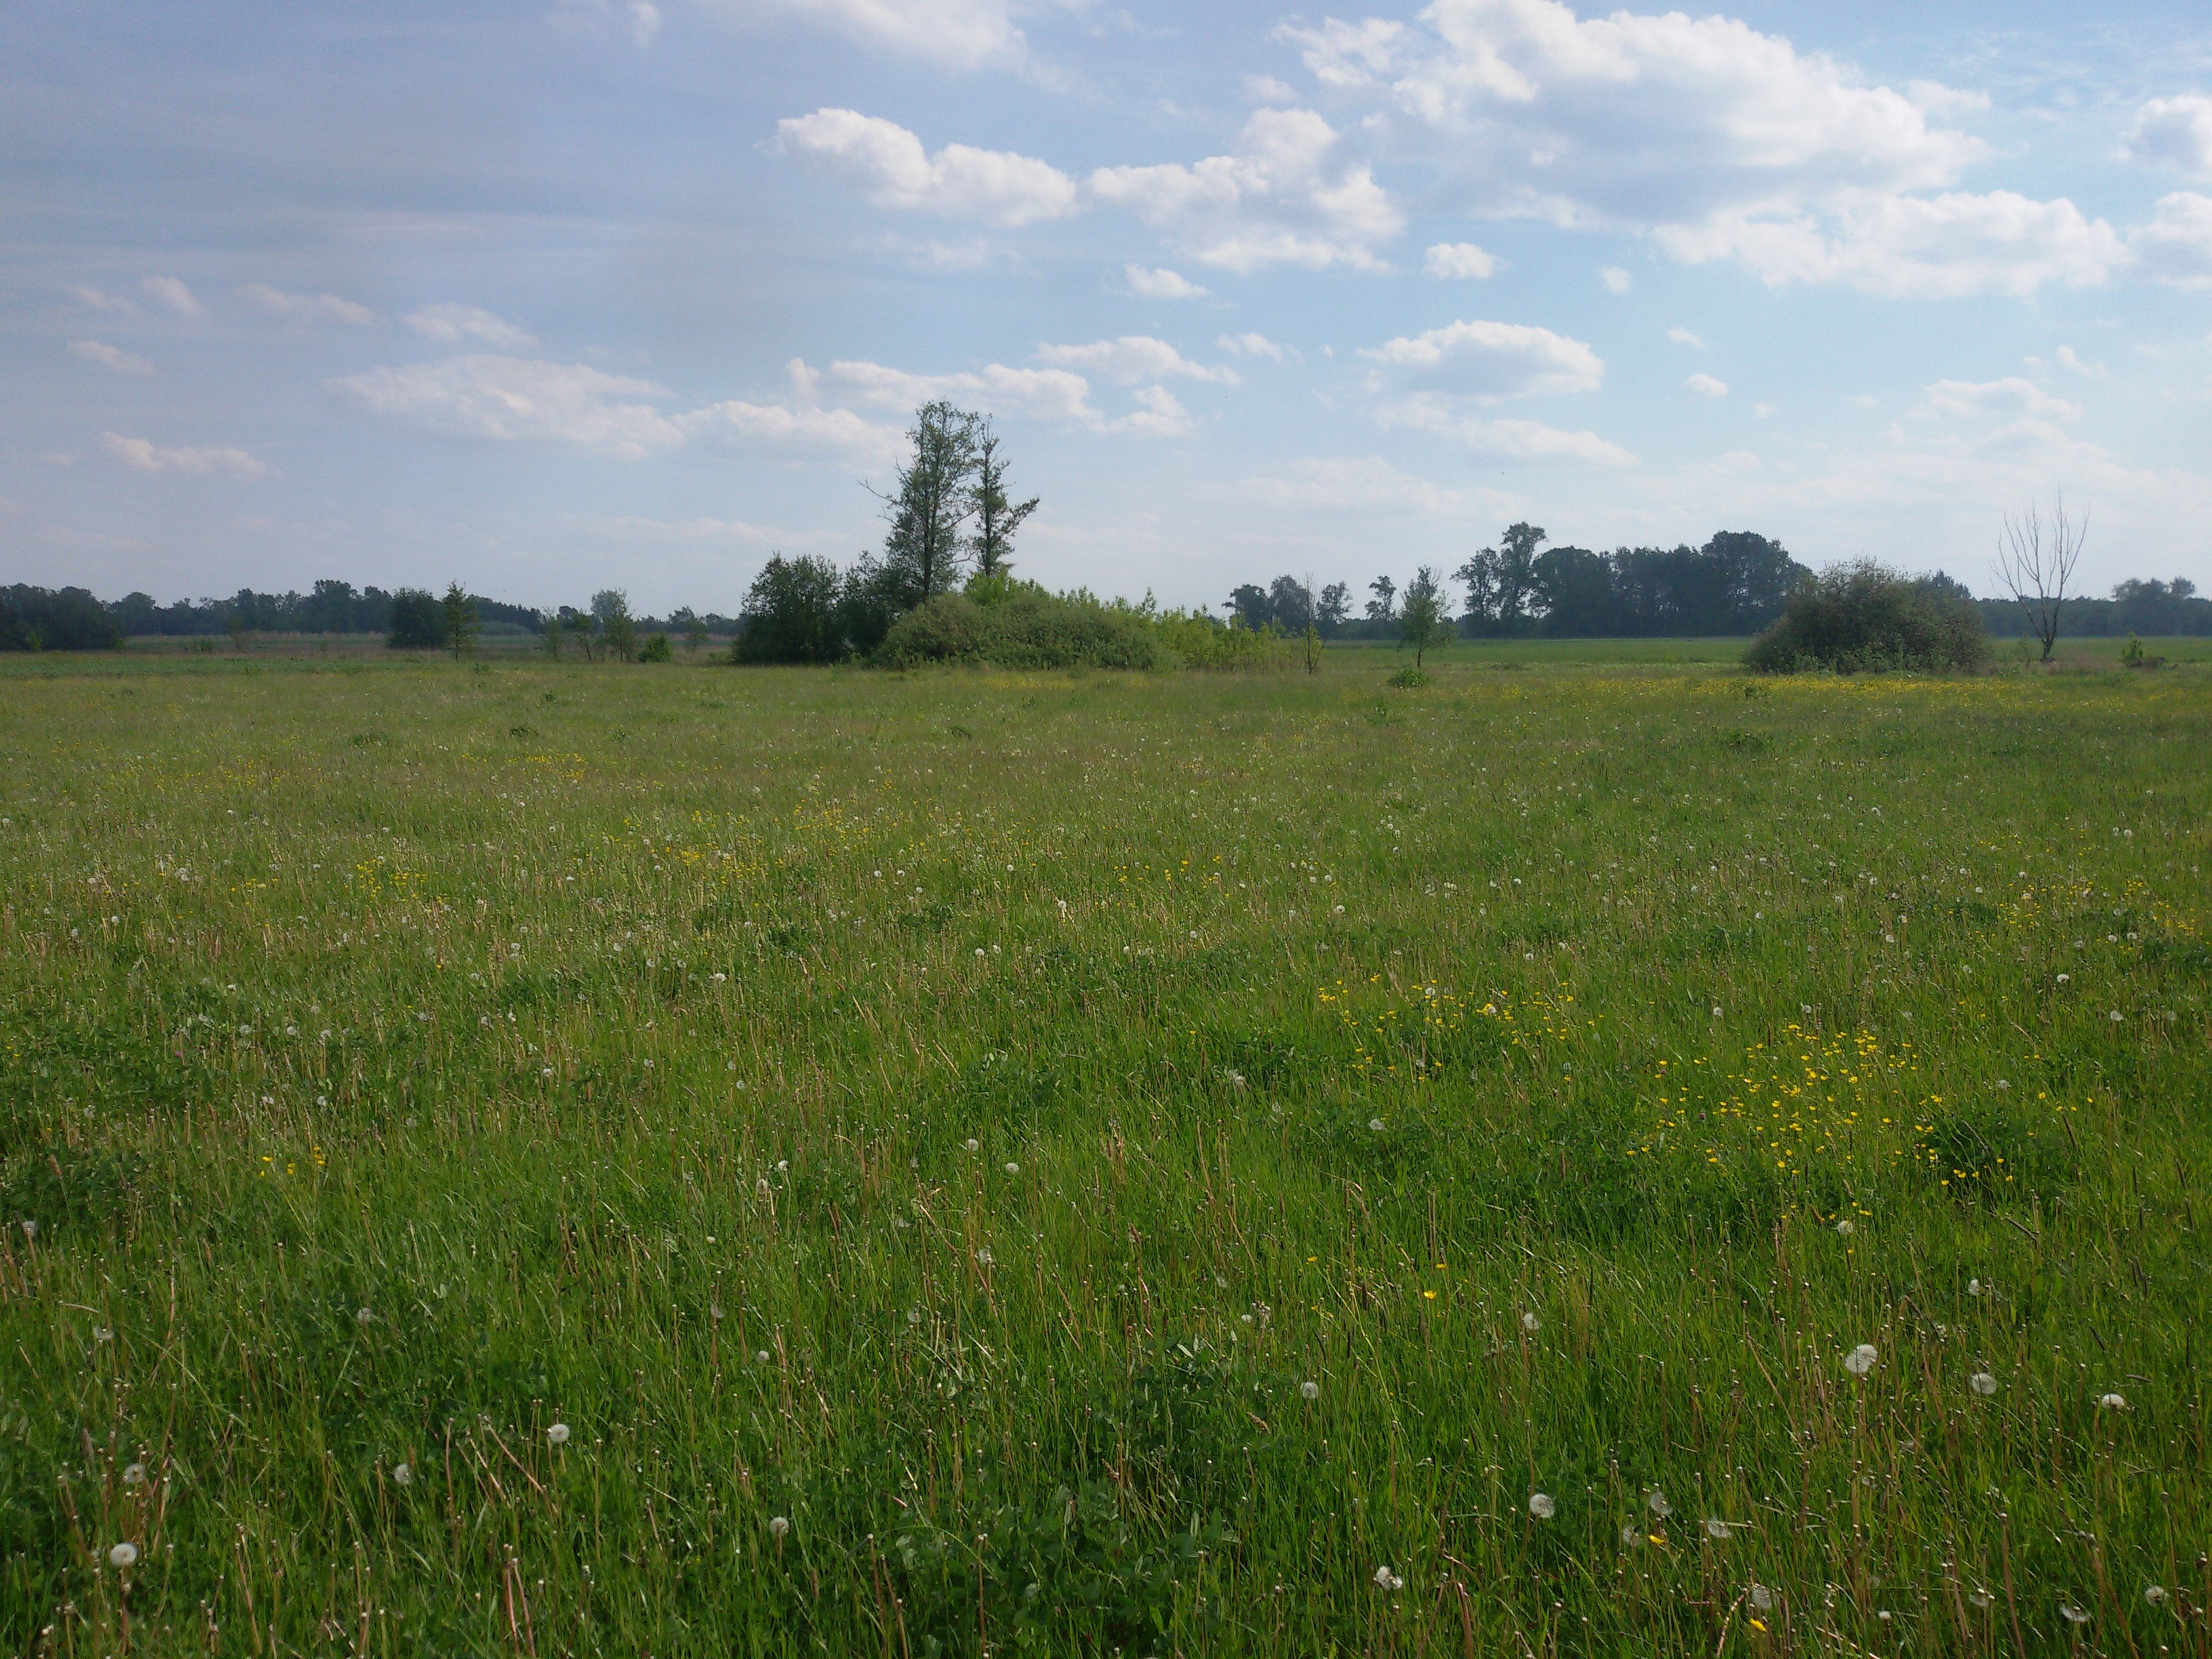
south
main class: Grassland
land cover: Grassland without tree/shrub cover
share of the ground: > 75 %
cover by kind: herbaceous plants 100 %
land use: Agriculture (excluding fallow land and kitchen gardens)
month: May
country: PL
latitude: 51.6197
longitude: 21.6514
